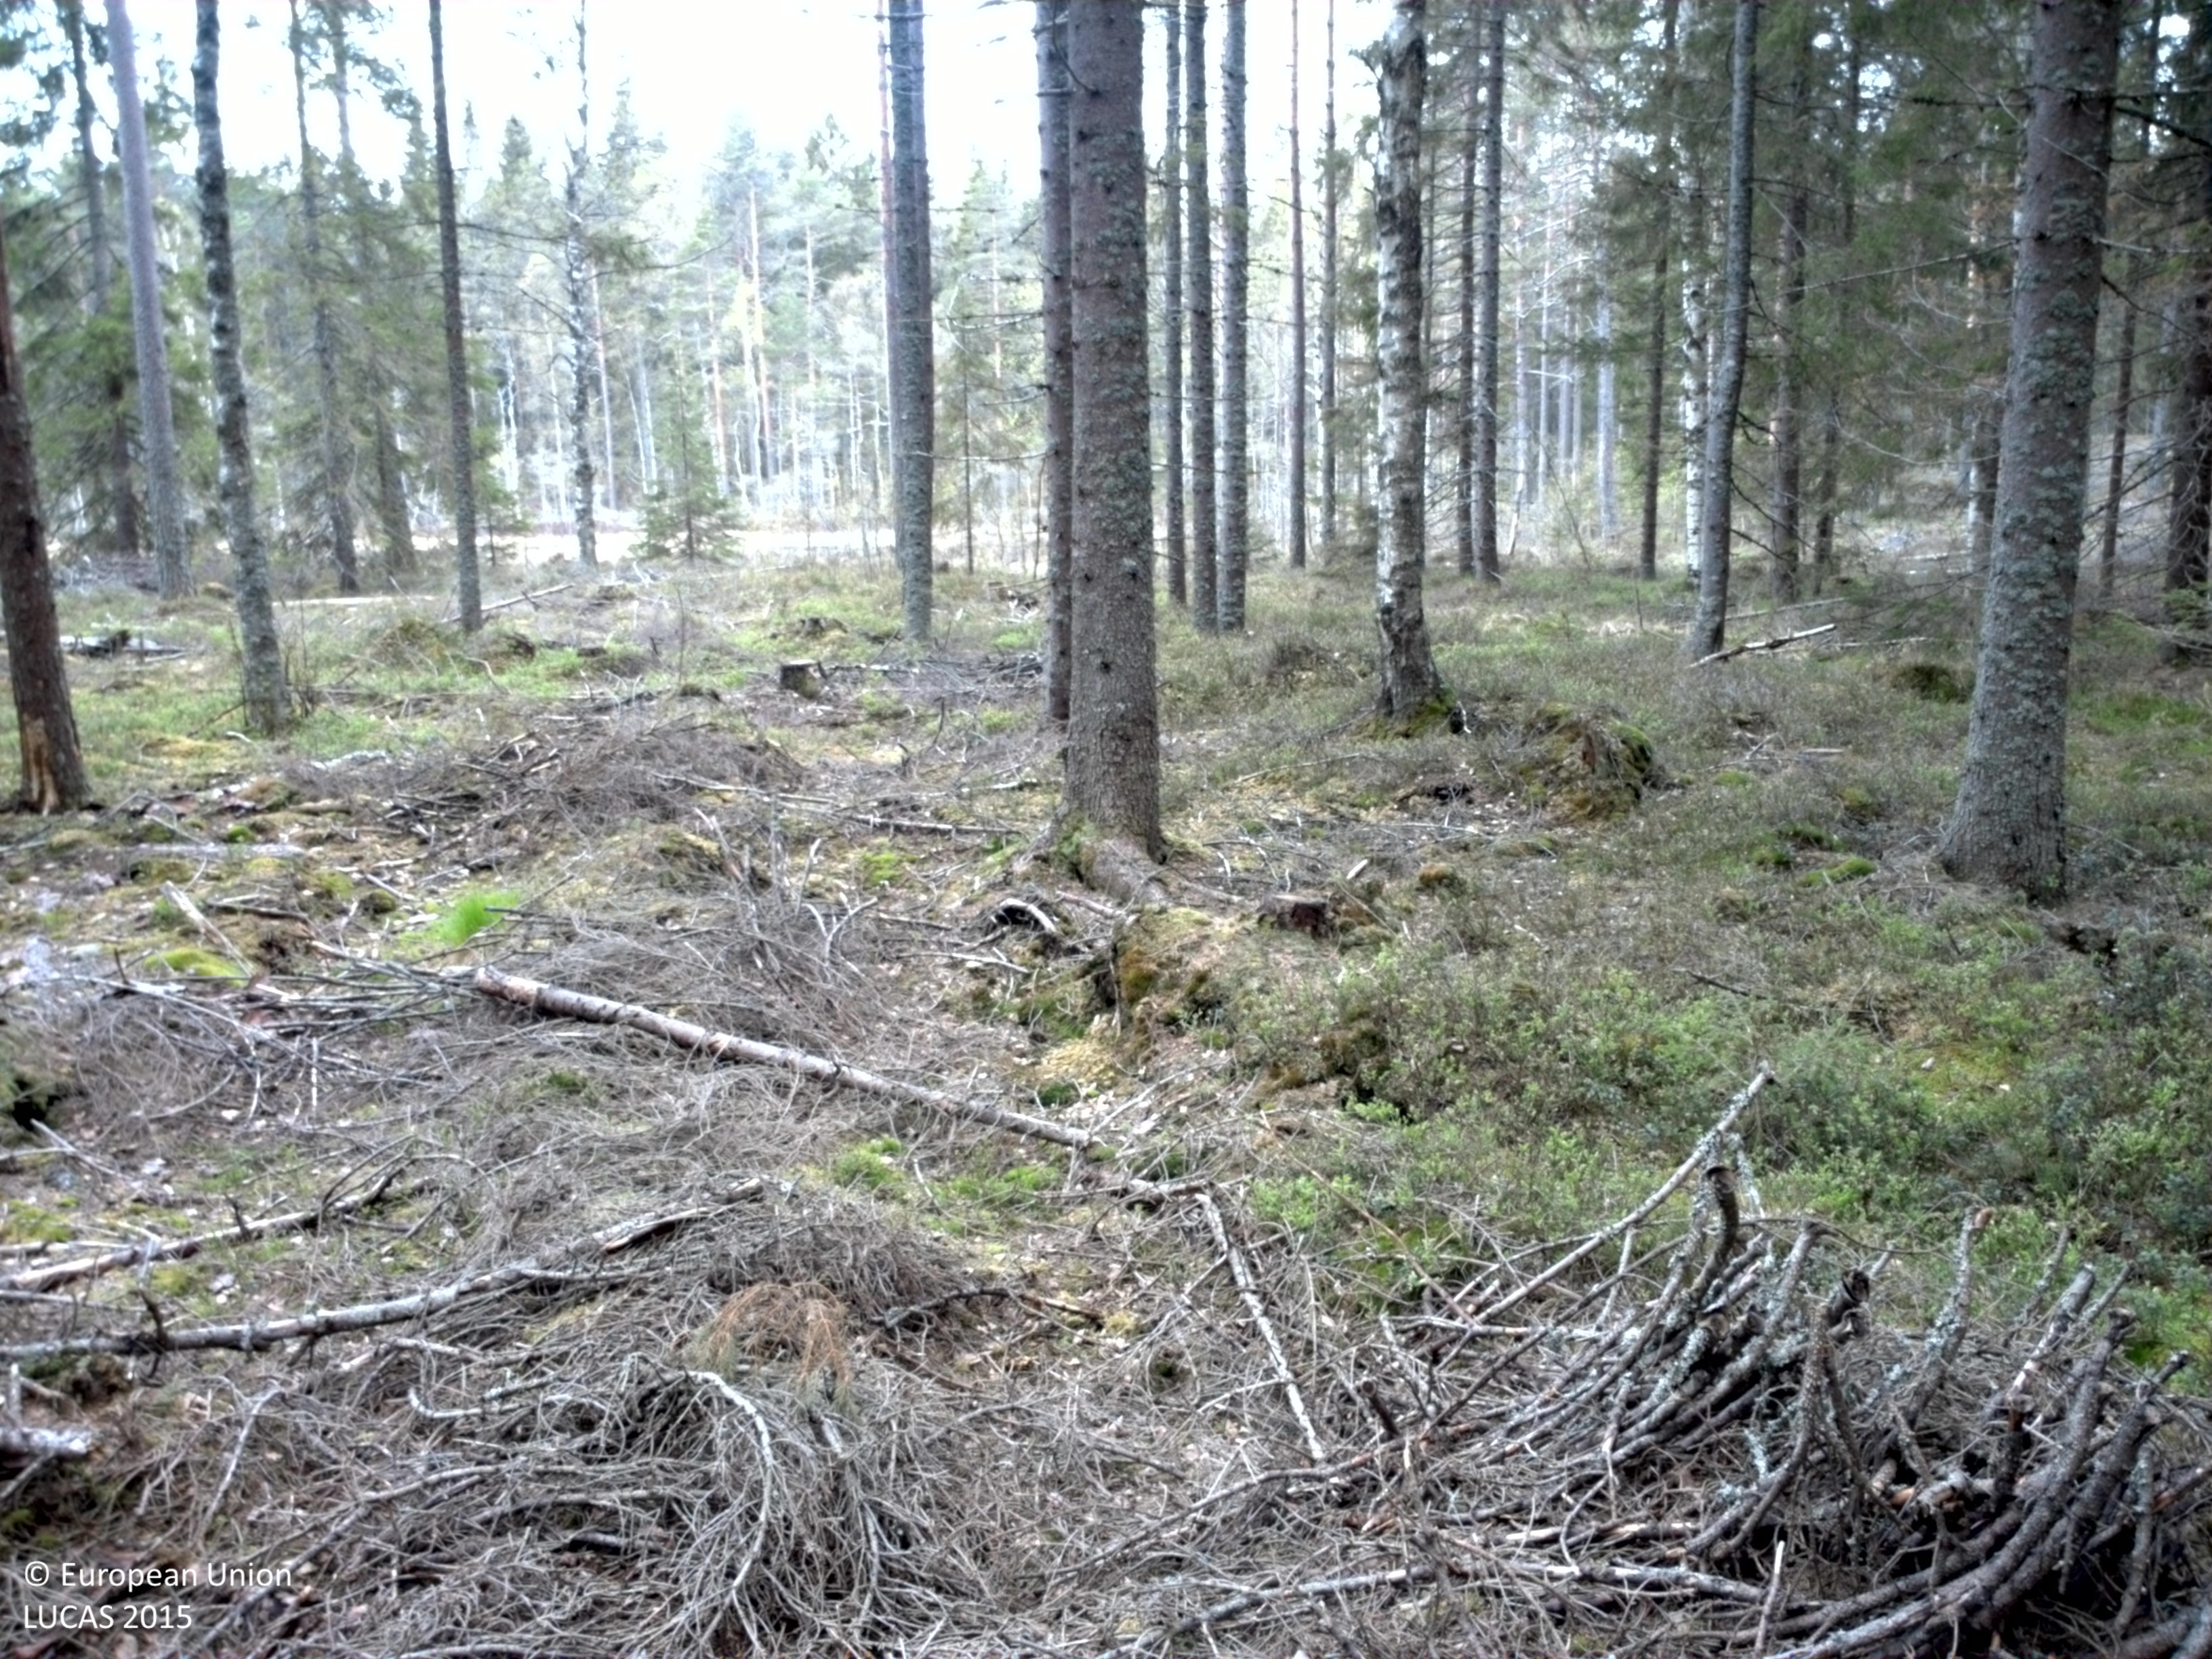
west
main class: Woodland
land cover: Spruce dominated coniferous woodland
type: boreal forest
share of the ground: > 75 %
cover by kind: coniferous forest trees 70 %, shrubs 15 %, lichens and mosses 10 %, broadleaved forest trees 5 %
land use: Forestry
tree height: > 5 m
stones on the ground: < 10 %
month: June
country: SE
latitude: 59.4613
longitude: 12.1998
